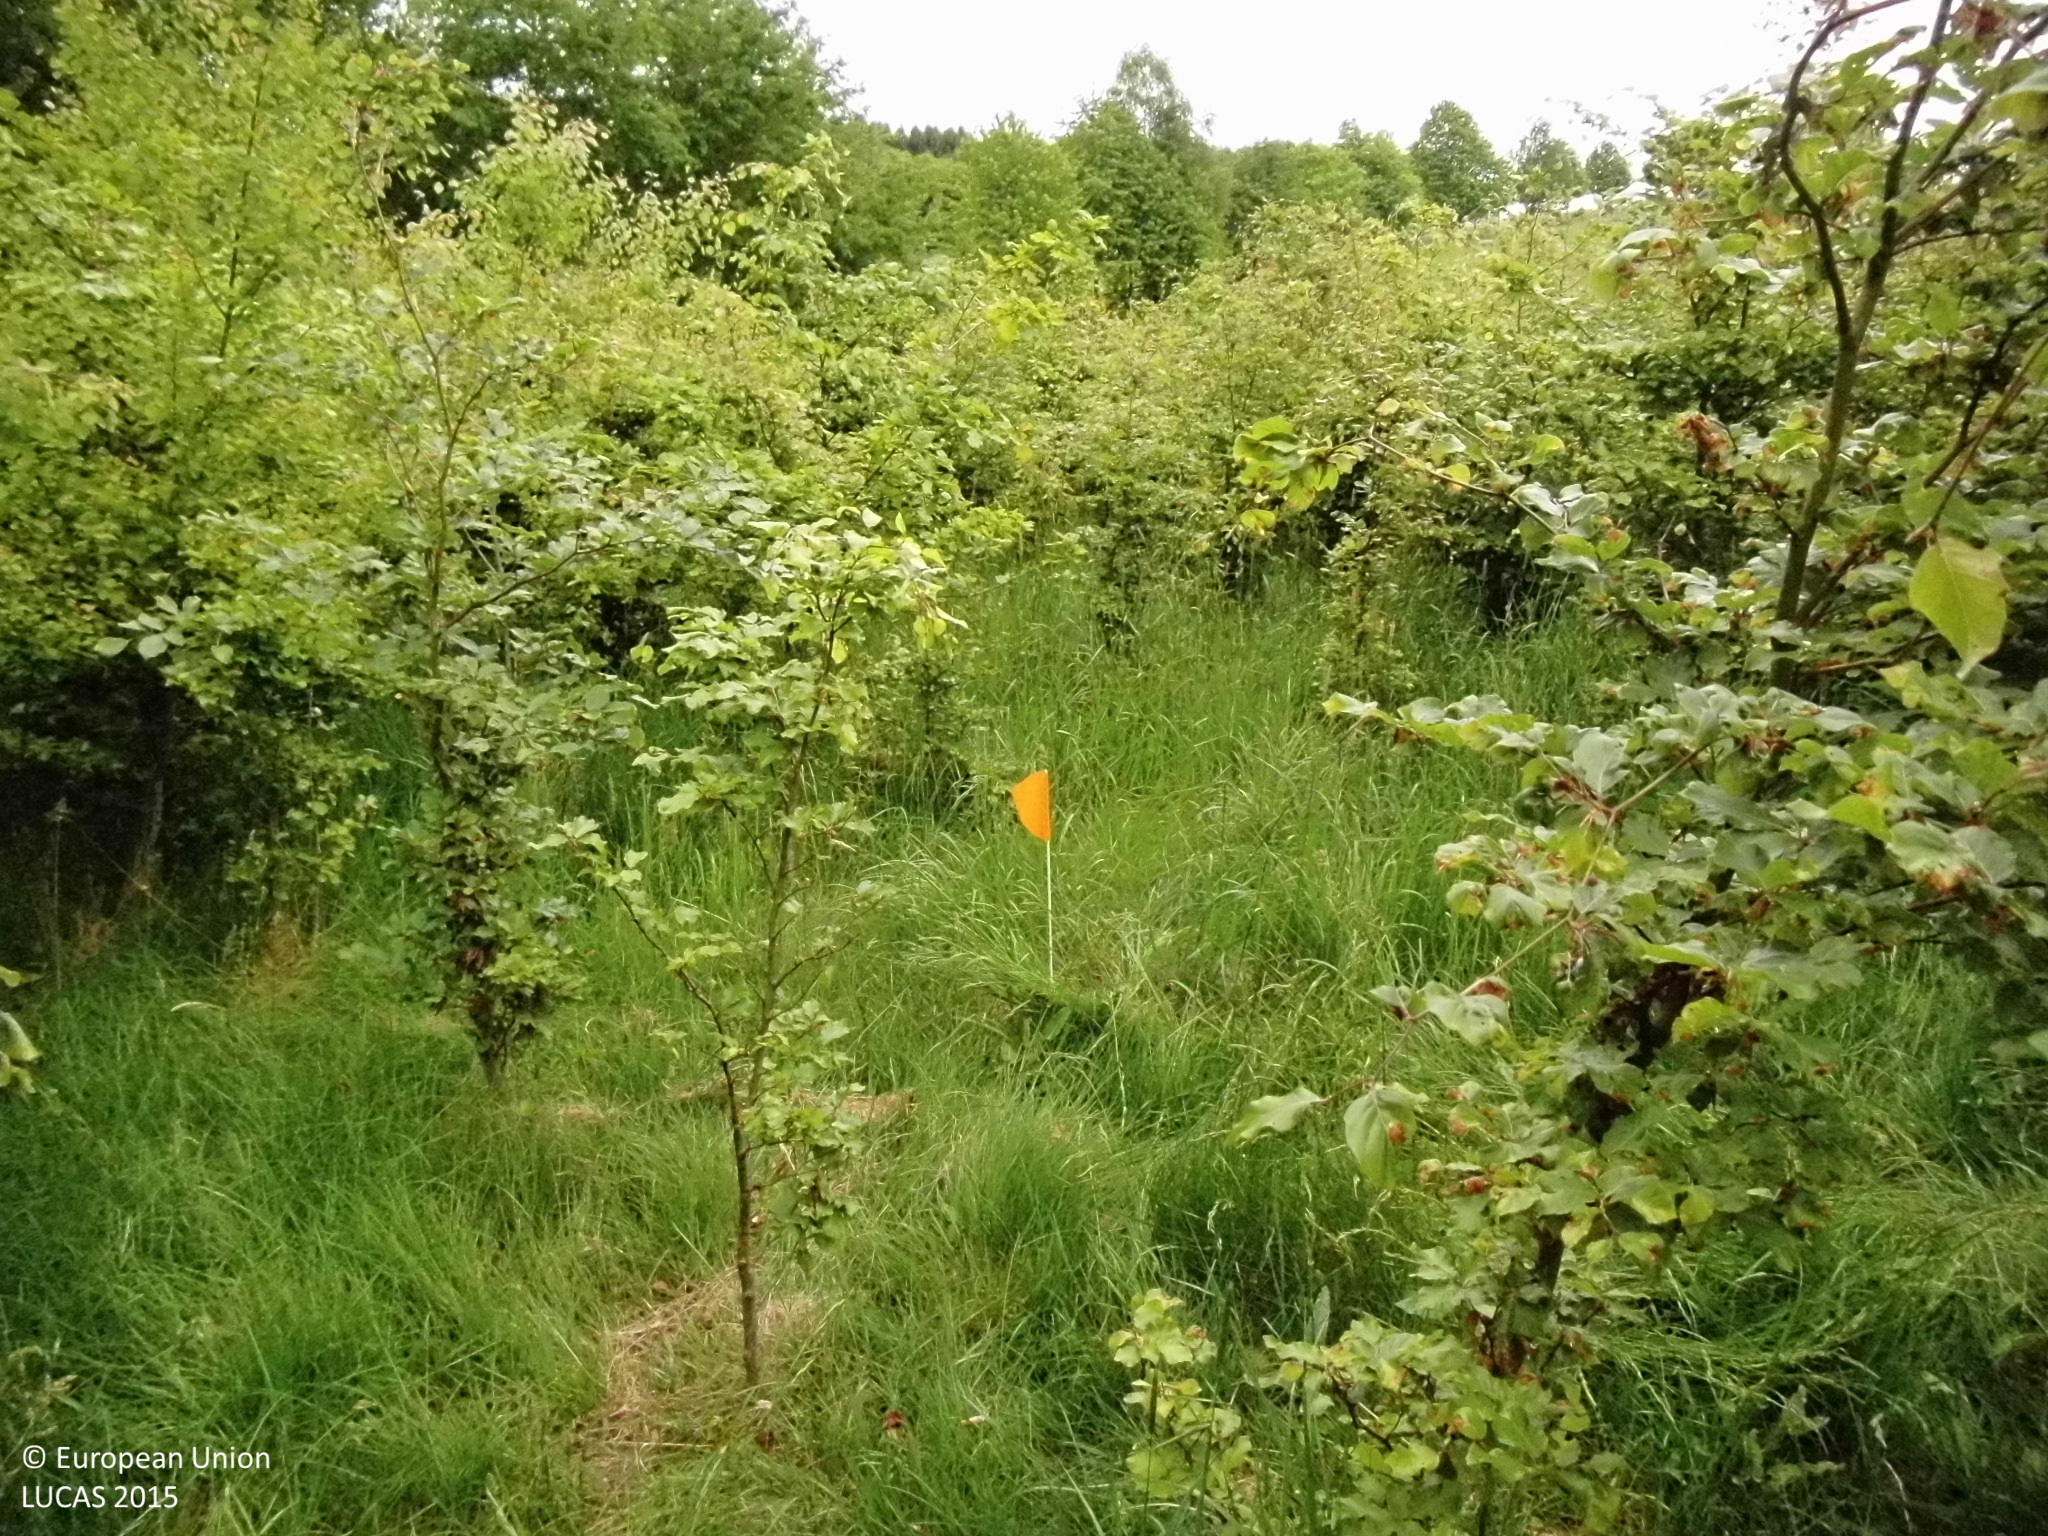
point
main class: Woodland
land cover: Broadleaved woodland
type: mesophytic deciduous forest
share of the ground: 50 - 75 %
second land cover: Grassland without tree/shrub cover
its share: > 75 %
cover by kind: broadleaved forest trees 65 %, herbaceous plants 35 %
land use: Forestry
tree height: < 5 m
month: May
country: DE
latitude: 50.8947
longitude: 7.5122
